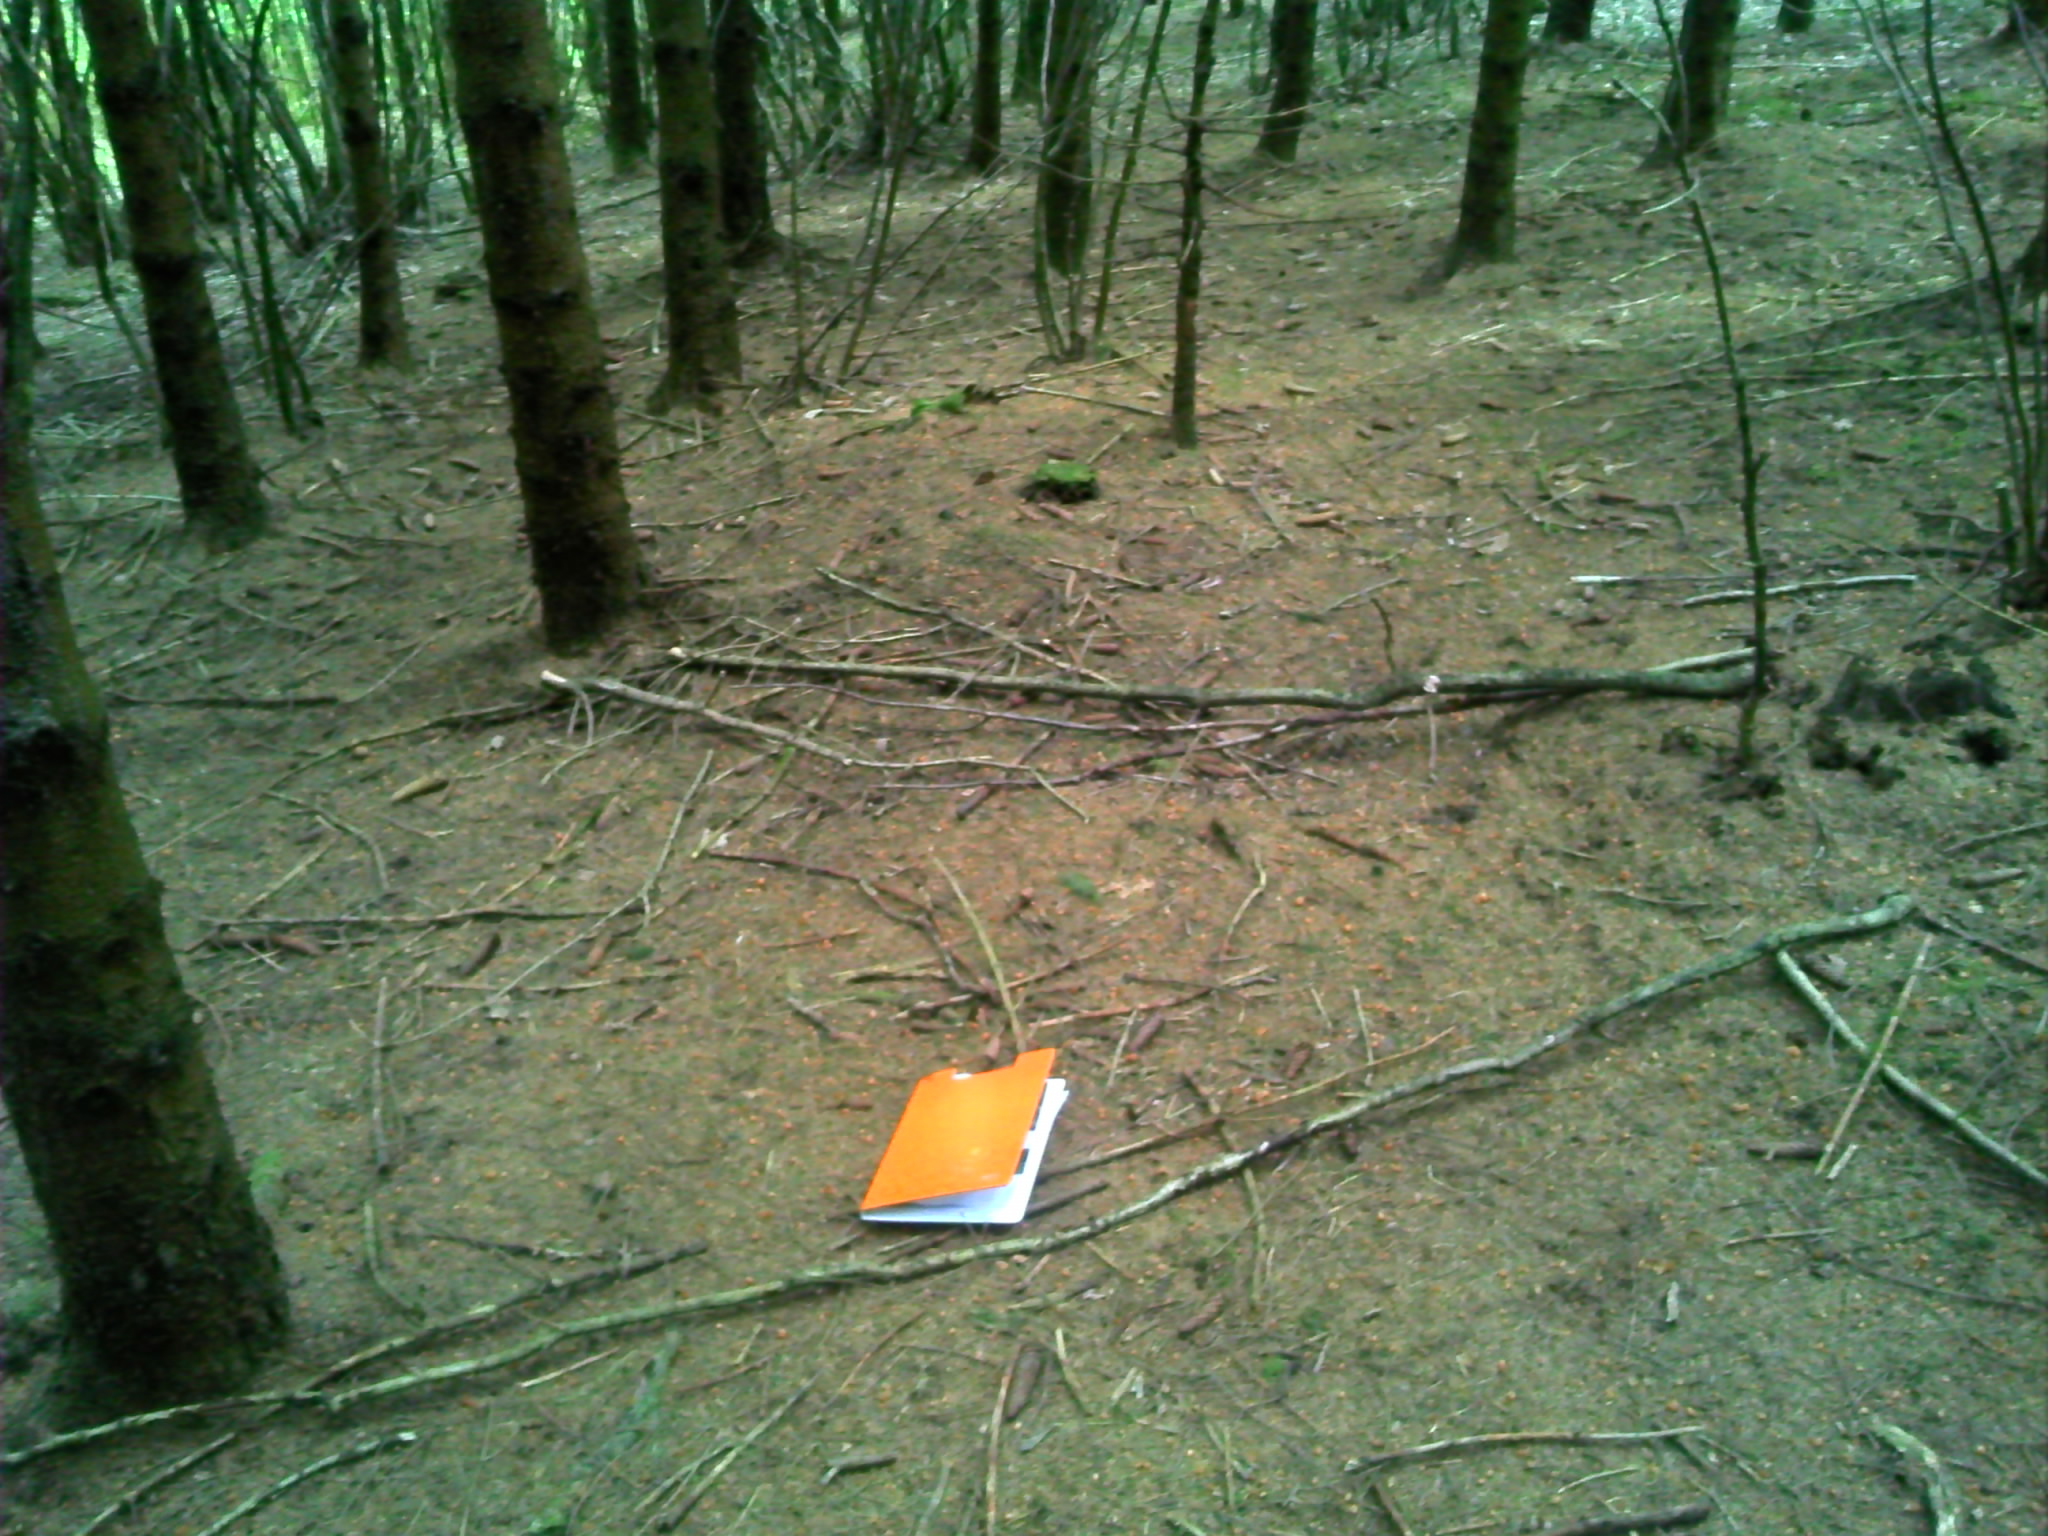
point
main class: Woodland
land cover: Spruce dominated coniferous woodland
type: exotic forest
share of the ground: > 75 %
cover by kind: coniferous forest trees 75 %, broadleaved forest trees 25 %
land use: Forestry
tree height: > 5 m
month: May
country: LU
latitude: 49.9321
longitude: 5.9450
